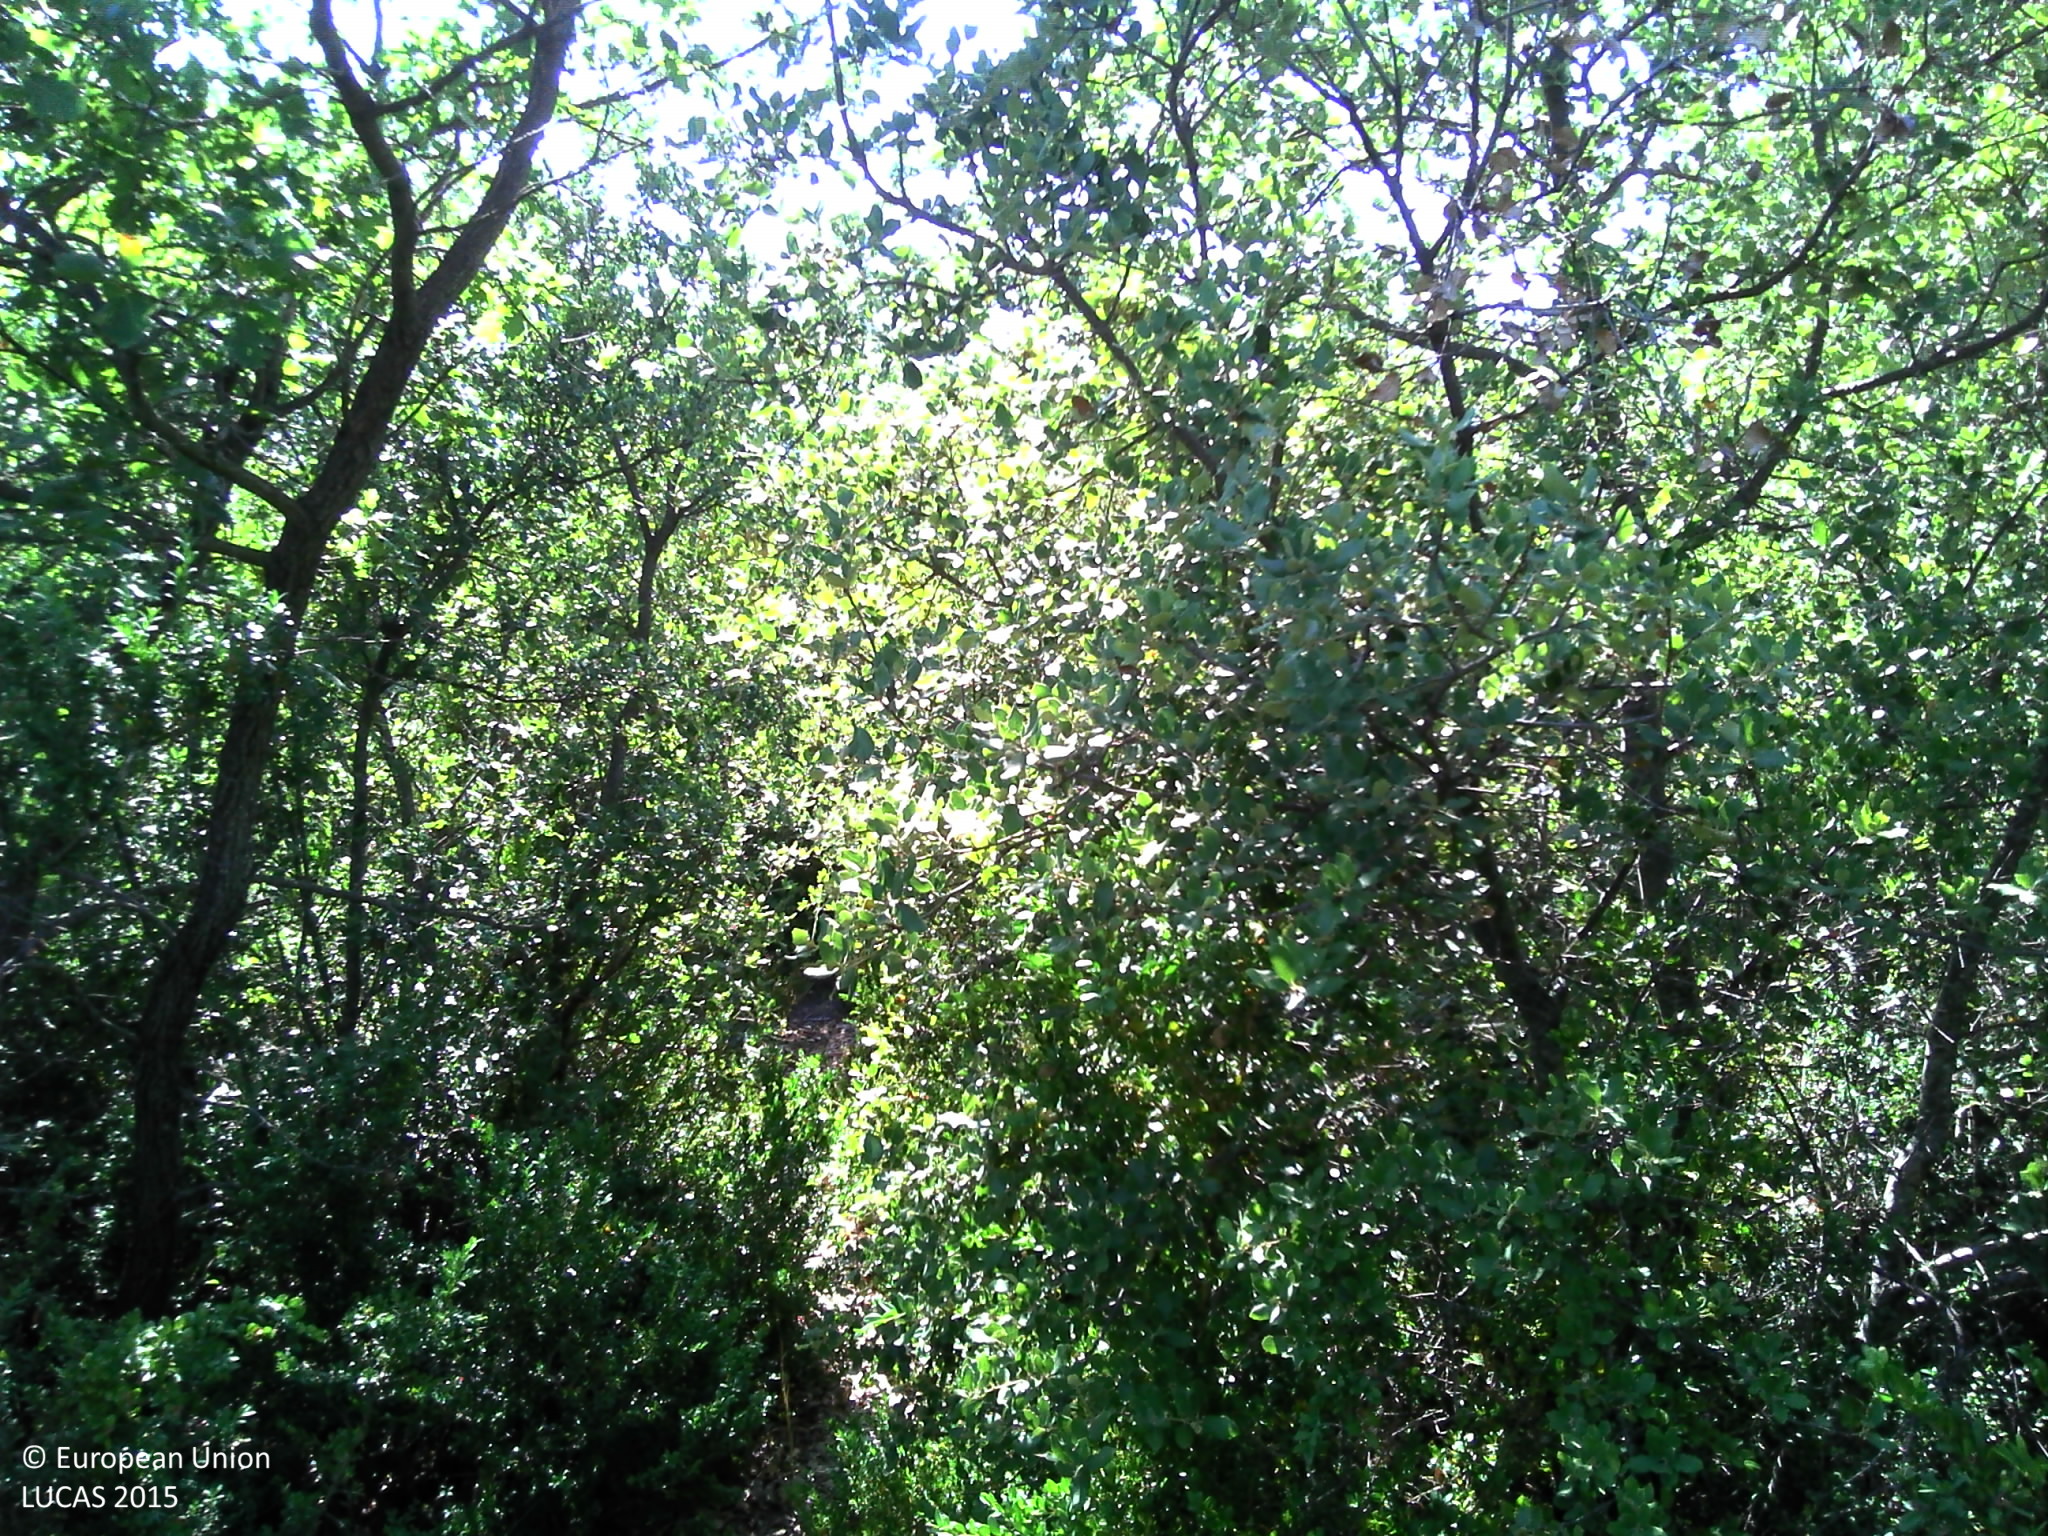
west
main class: Woodland
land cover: Broadleaved woodland
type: broadleaved evergreen forest
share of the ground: > 75 %
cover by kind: broadleaved forest trees 70 %, shrubs 15 %, coniferous forest trees 5 %, herbaceous plants 5 %, unconsolidated bare surface 5 %
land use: Forestry
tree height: < 5 m
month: July
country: FR
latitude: 43.9498
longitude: 5.1864
